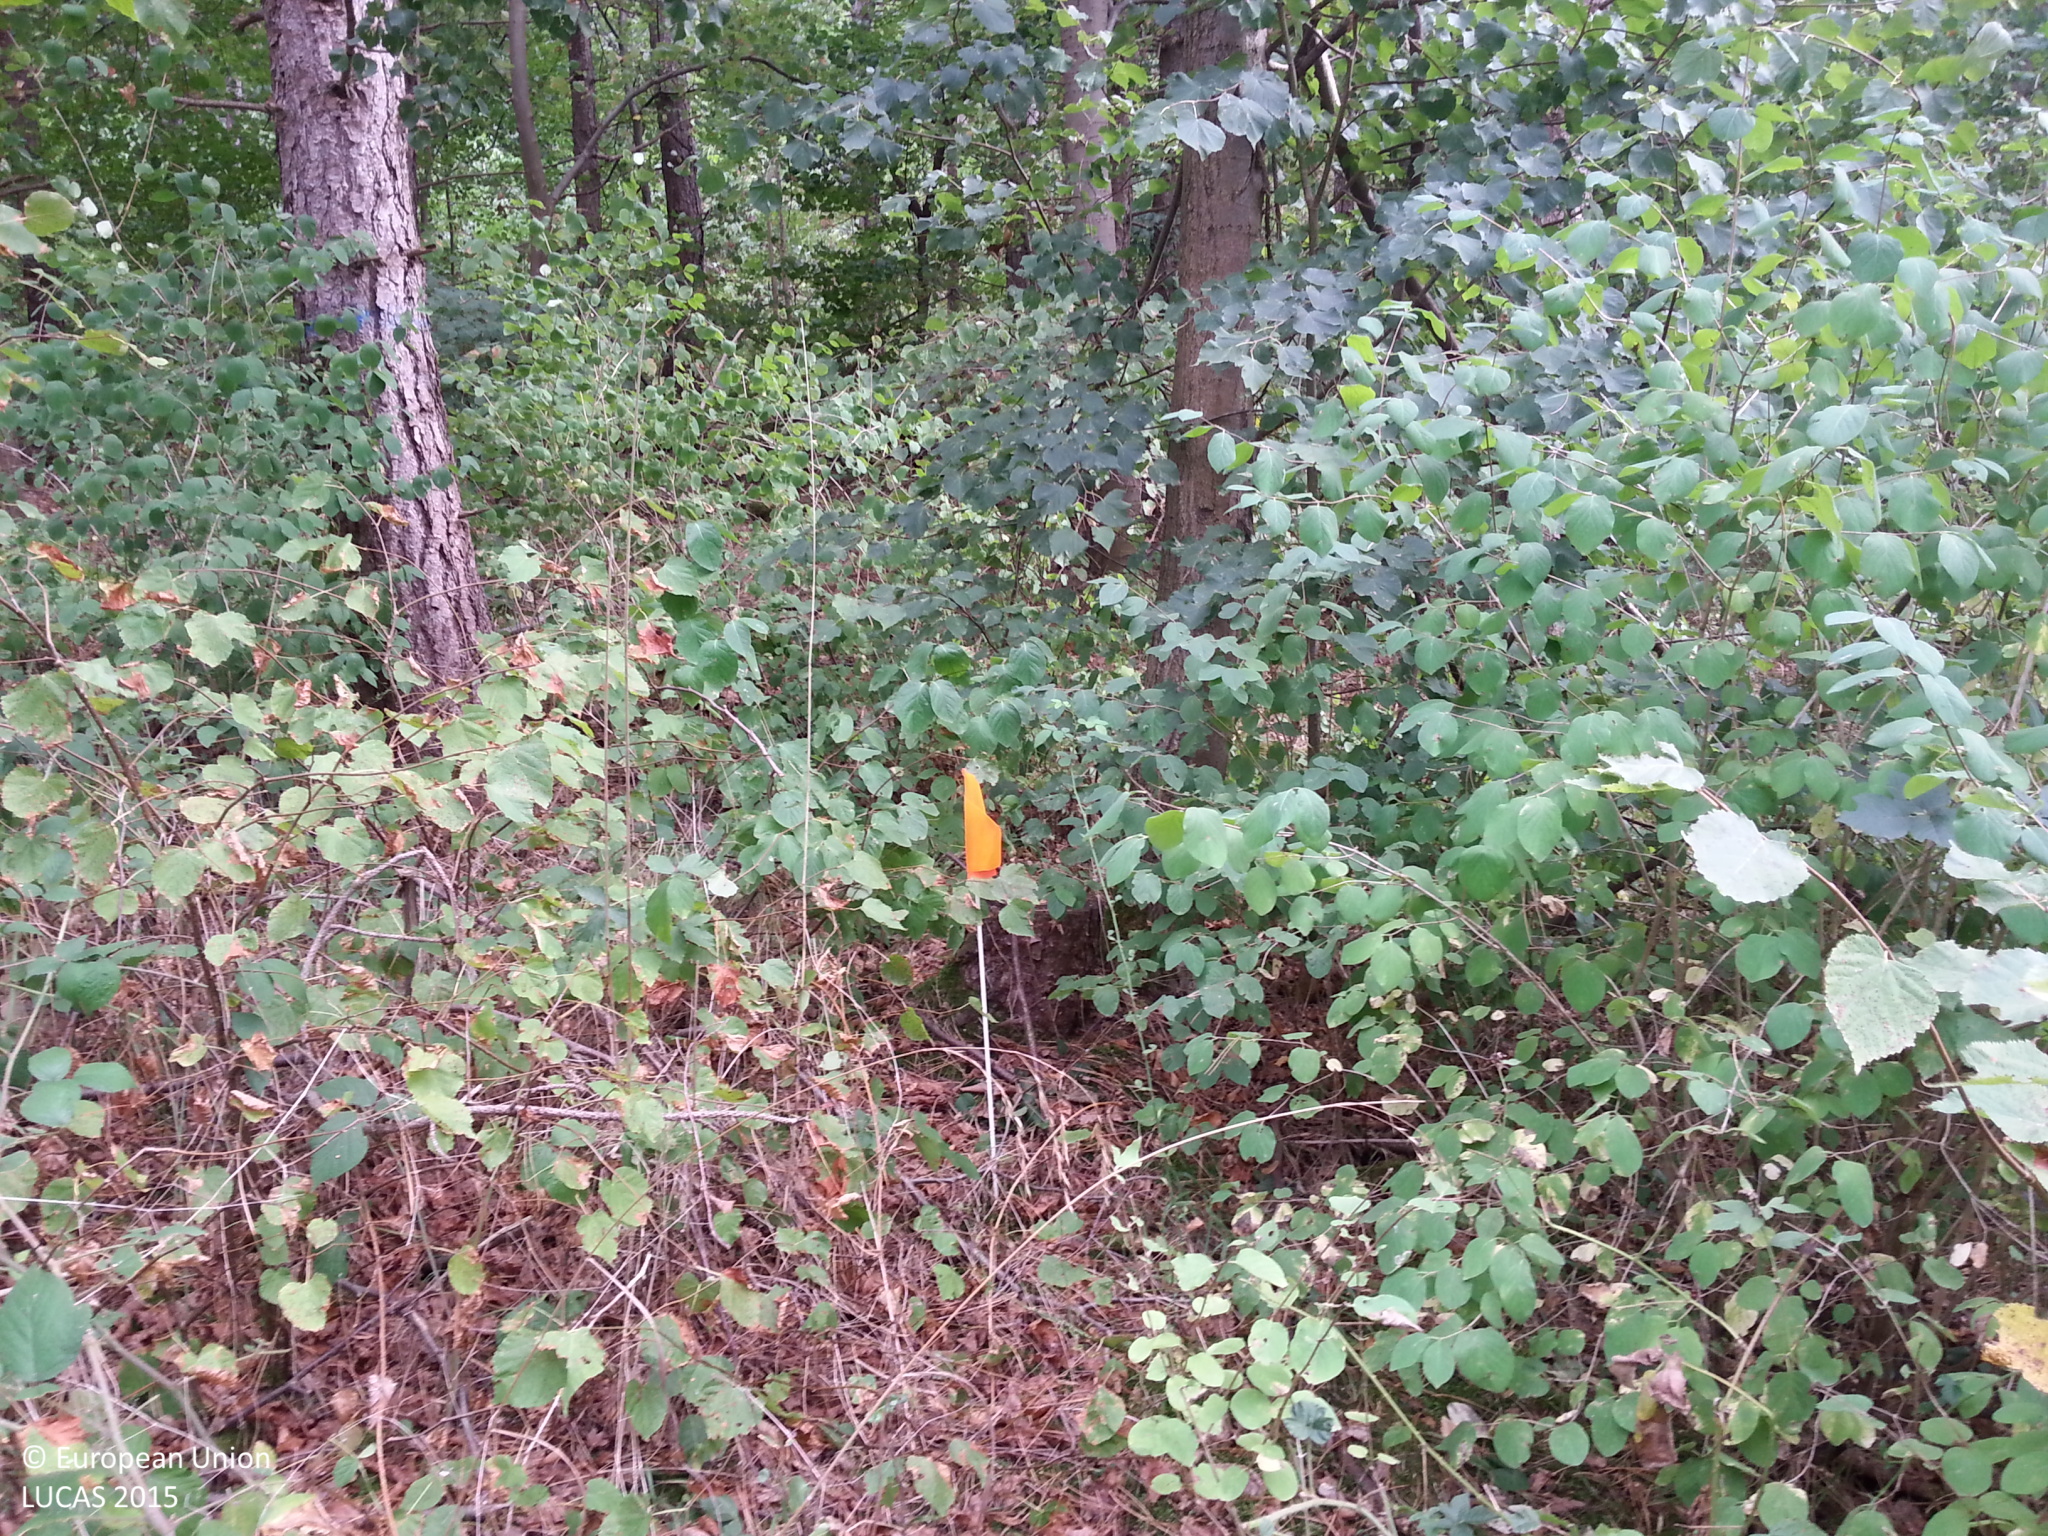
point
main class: Woodland
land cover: Pine dominated mixed woodland
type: hemiboreal forest and nemoral coniferous forest and mixed broadleaved-coniferous forest
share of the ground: 50 - 75 %
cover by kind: coniferous forest trees 40 %, broadleaved forest trees 30 %, shrubs 20 %, herbaceous plants 5 %, lichens and mosses 5 %
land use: Forestry
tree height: > 5 m
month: September
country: DE
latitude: 49.5900
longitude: 9.5713
